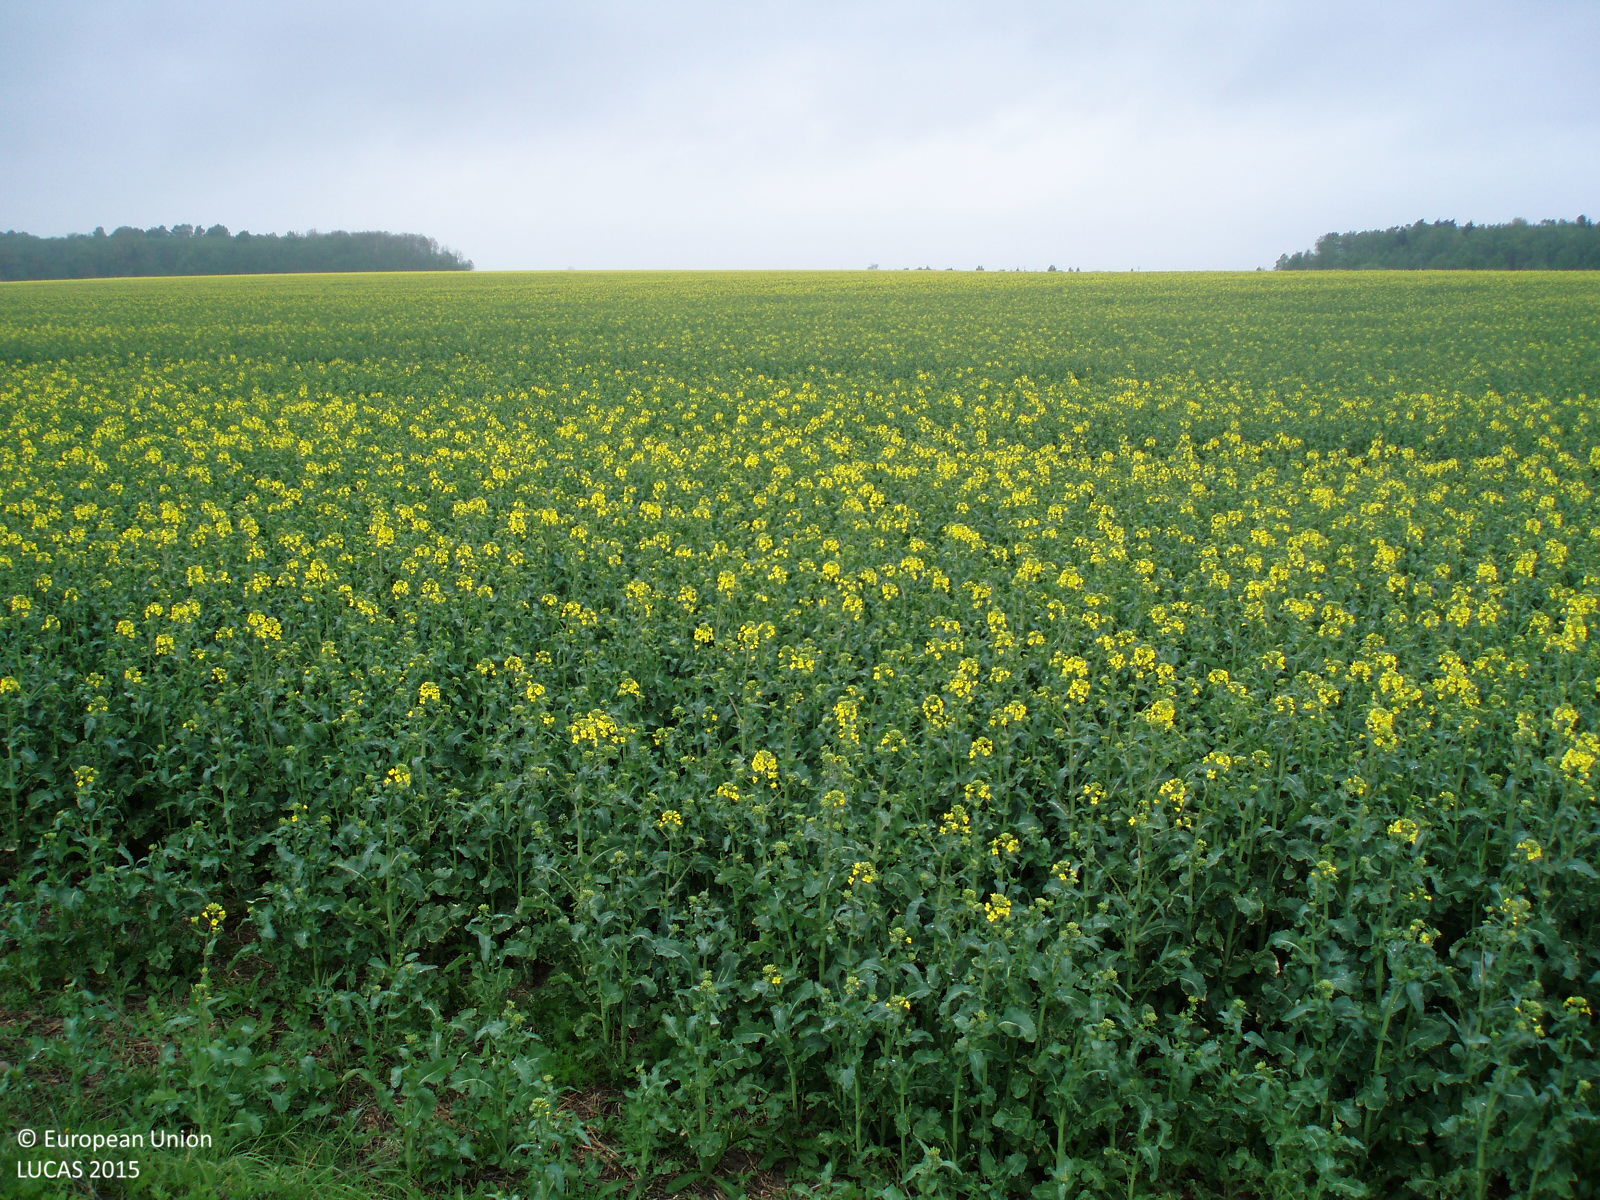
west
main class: Cropland
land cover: Rape and turnip rape
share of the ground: > 75 %
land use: Agriculture (excluding fallow land and kitchen gardens)
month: May
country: LT
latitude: 56.3507
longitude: 22.9297
